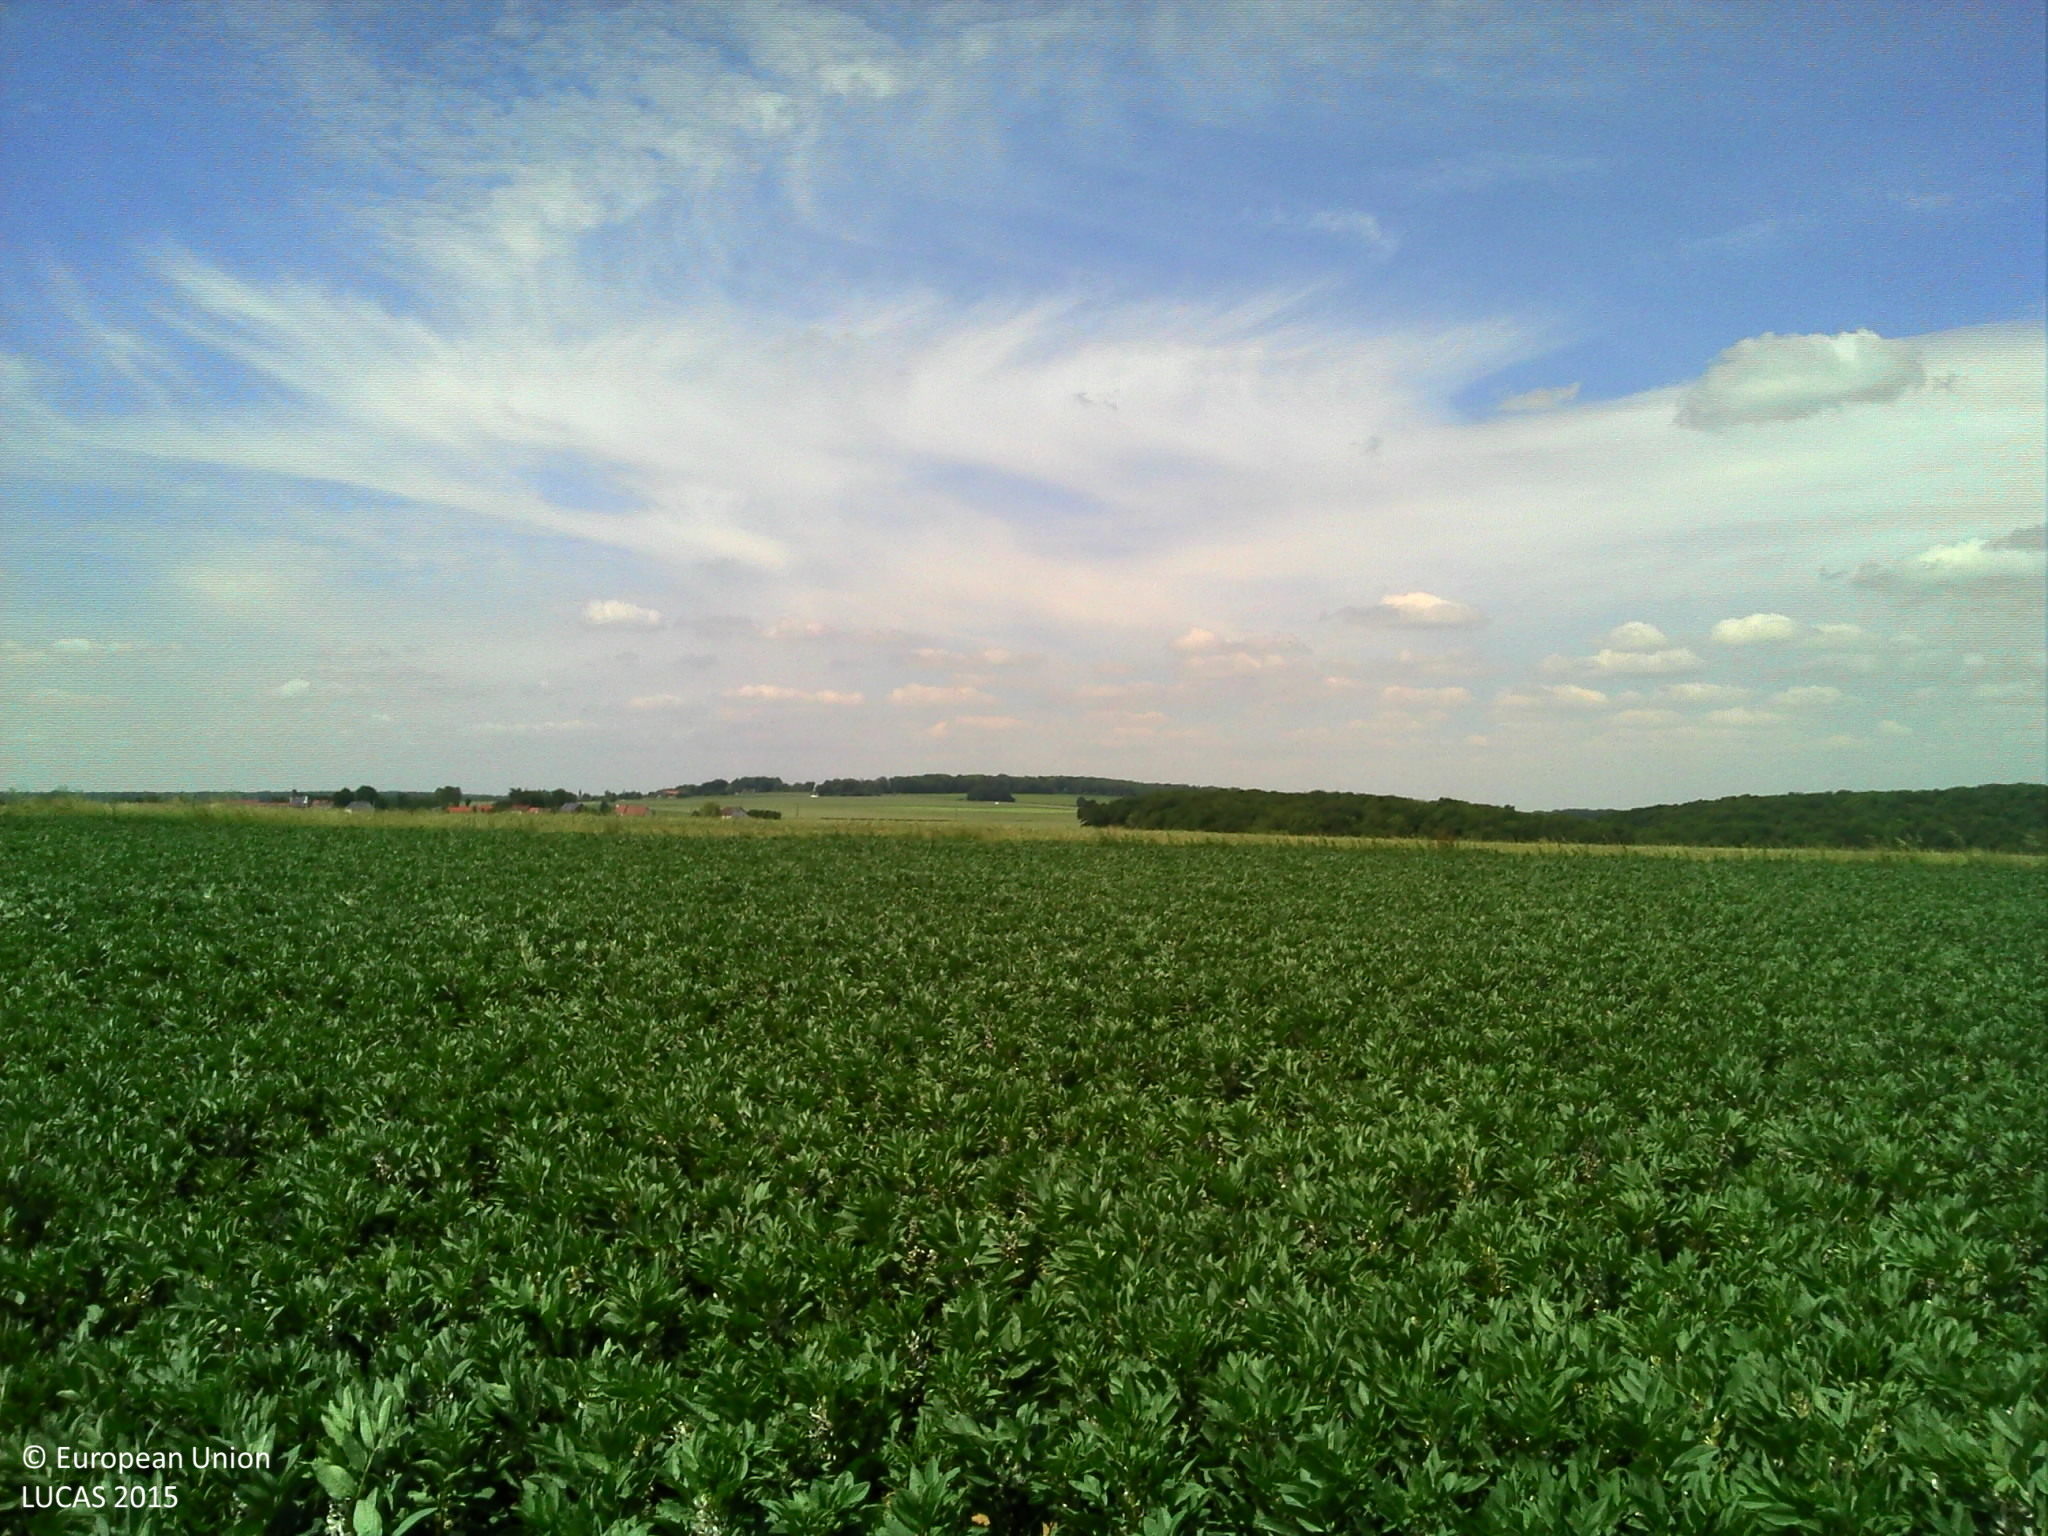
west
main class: Cropland
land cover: Dry pulses
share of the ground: > 75 %
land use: Agriculture (excluding fallow land and kitchen gardens)
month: June
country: FR
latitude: 49.6299
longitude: 2.4978
